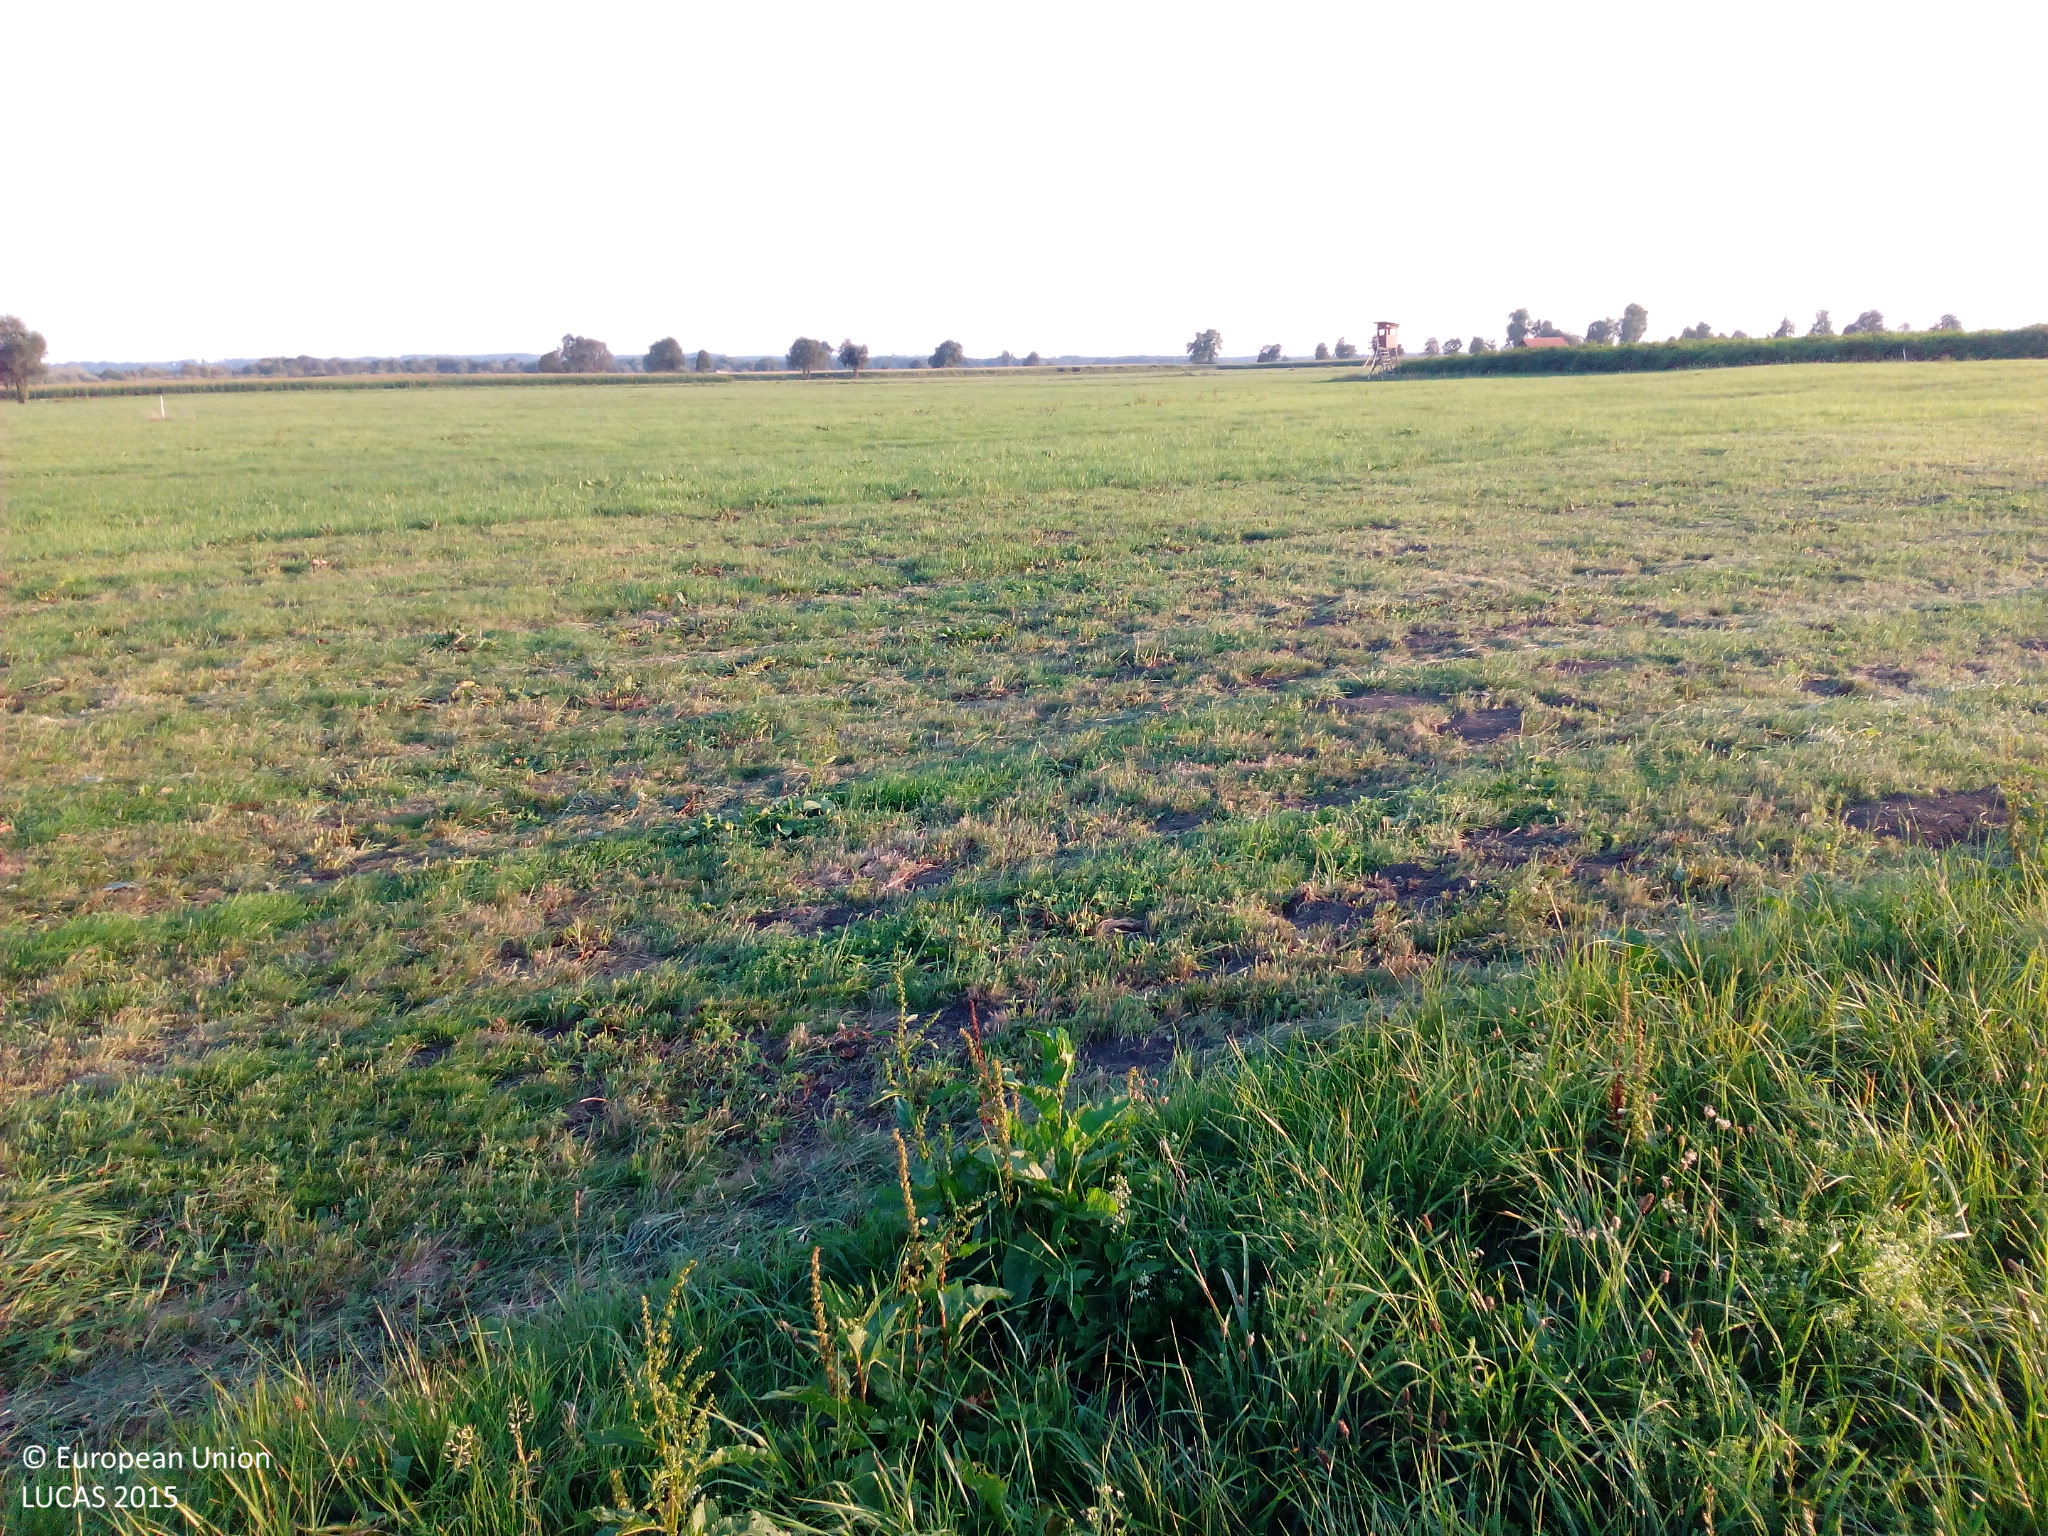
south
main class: Grassland
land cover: Grassland without tree/shrub cover
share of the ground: > 75 %
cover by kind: herbaceous plants 100 %
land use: Agriculture (excluding fallow land and kitchen gardens)
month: August
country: DE
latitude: 48.5290
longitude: 10.3113
